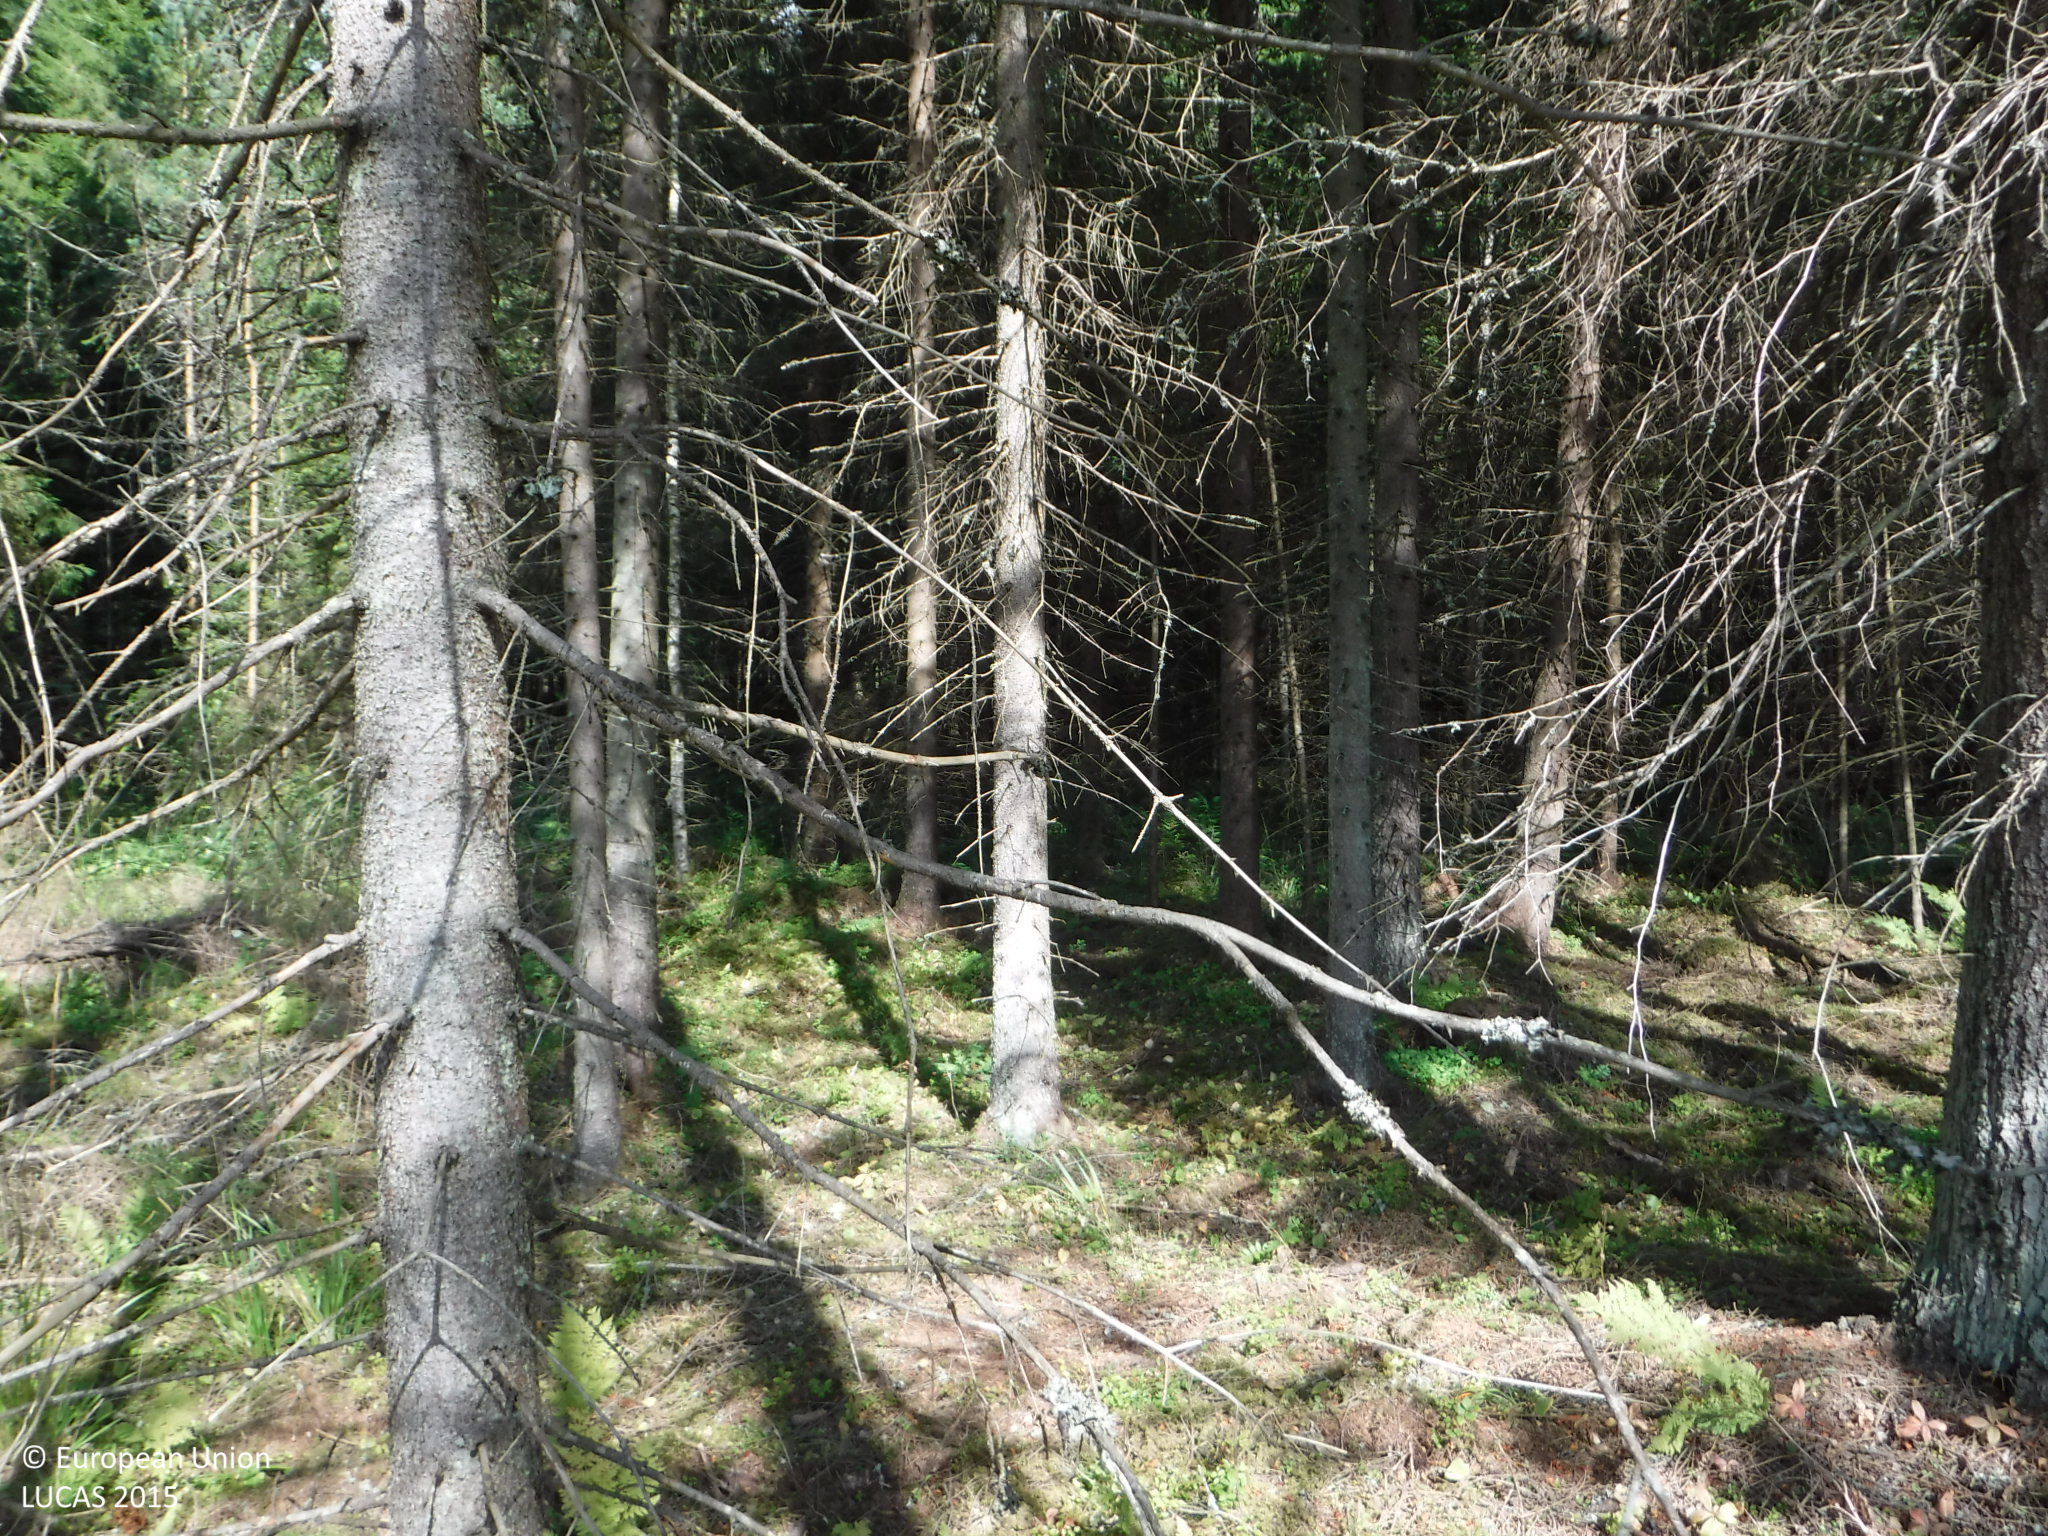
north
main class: Woodland
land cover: Spruce dominated coniferous woodland
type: boreal forest
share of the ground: > 75 %
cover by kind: coniferous forest trees 75 %, lichens and mosses 20 %, shrubs 5 %
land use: Forestry
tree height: > 5 m
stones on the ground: < 10 %
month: August
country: FI
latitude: 61.2624
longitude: 21.8963
